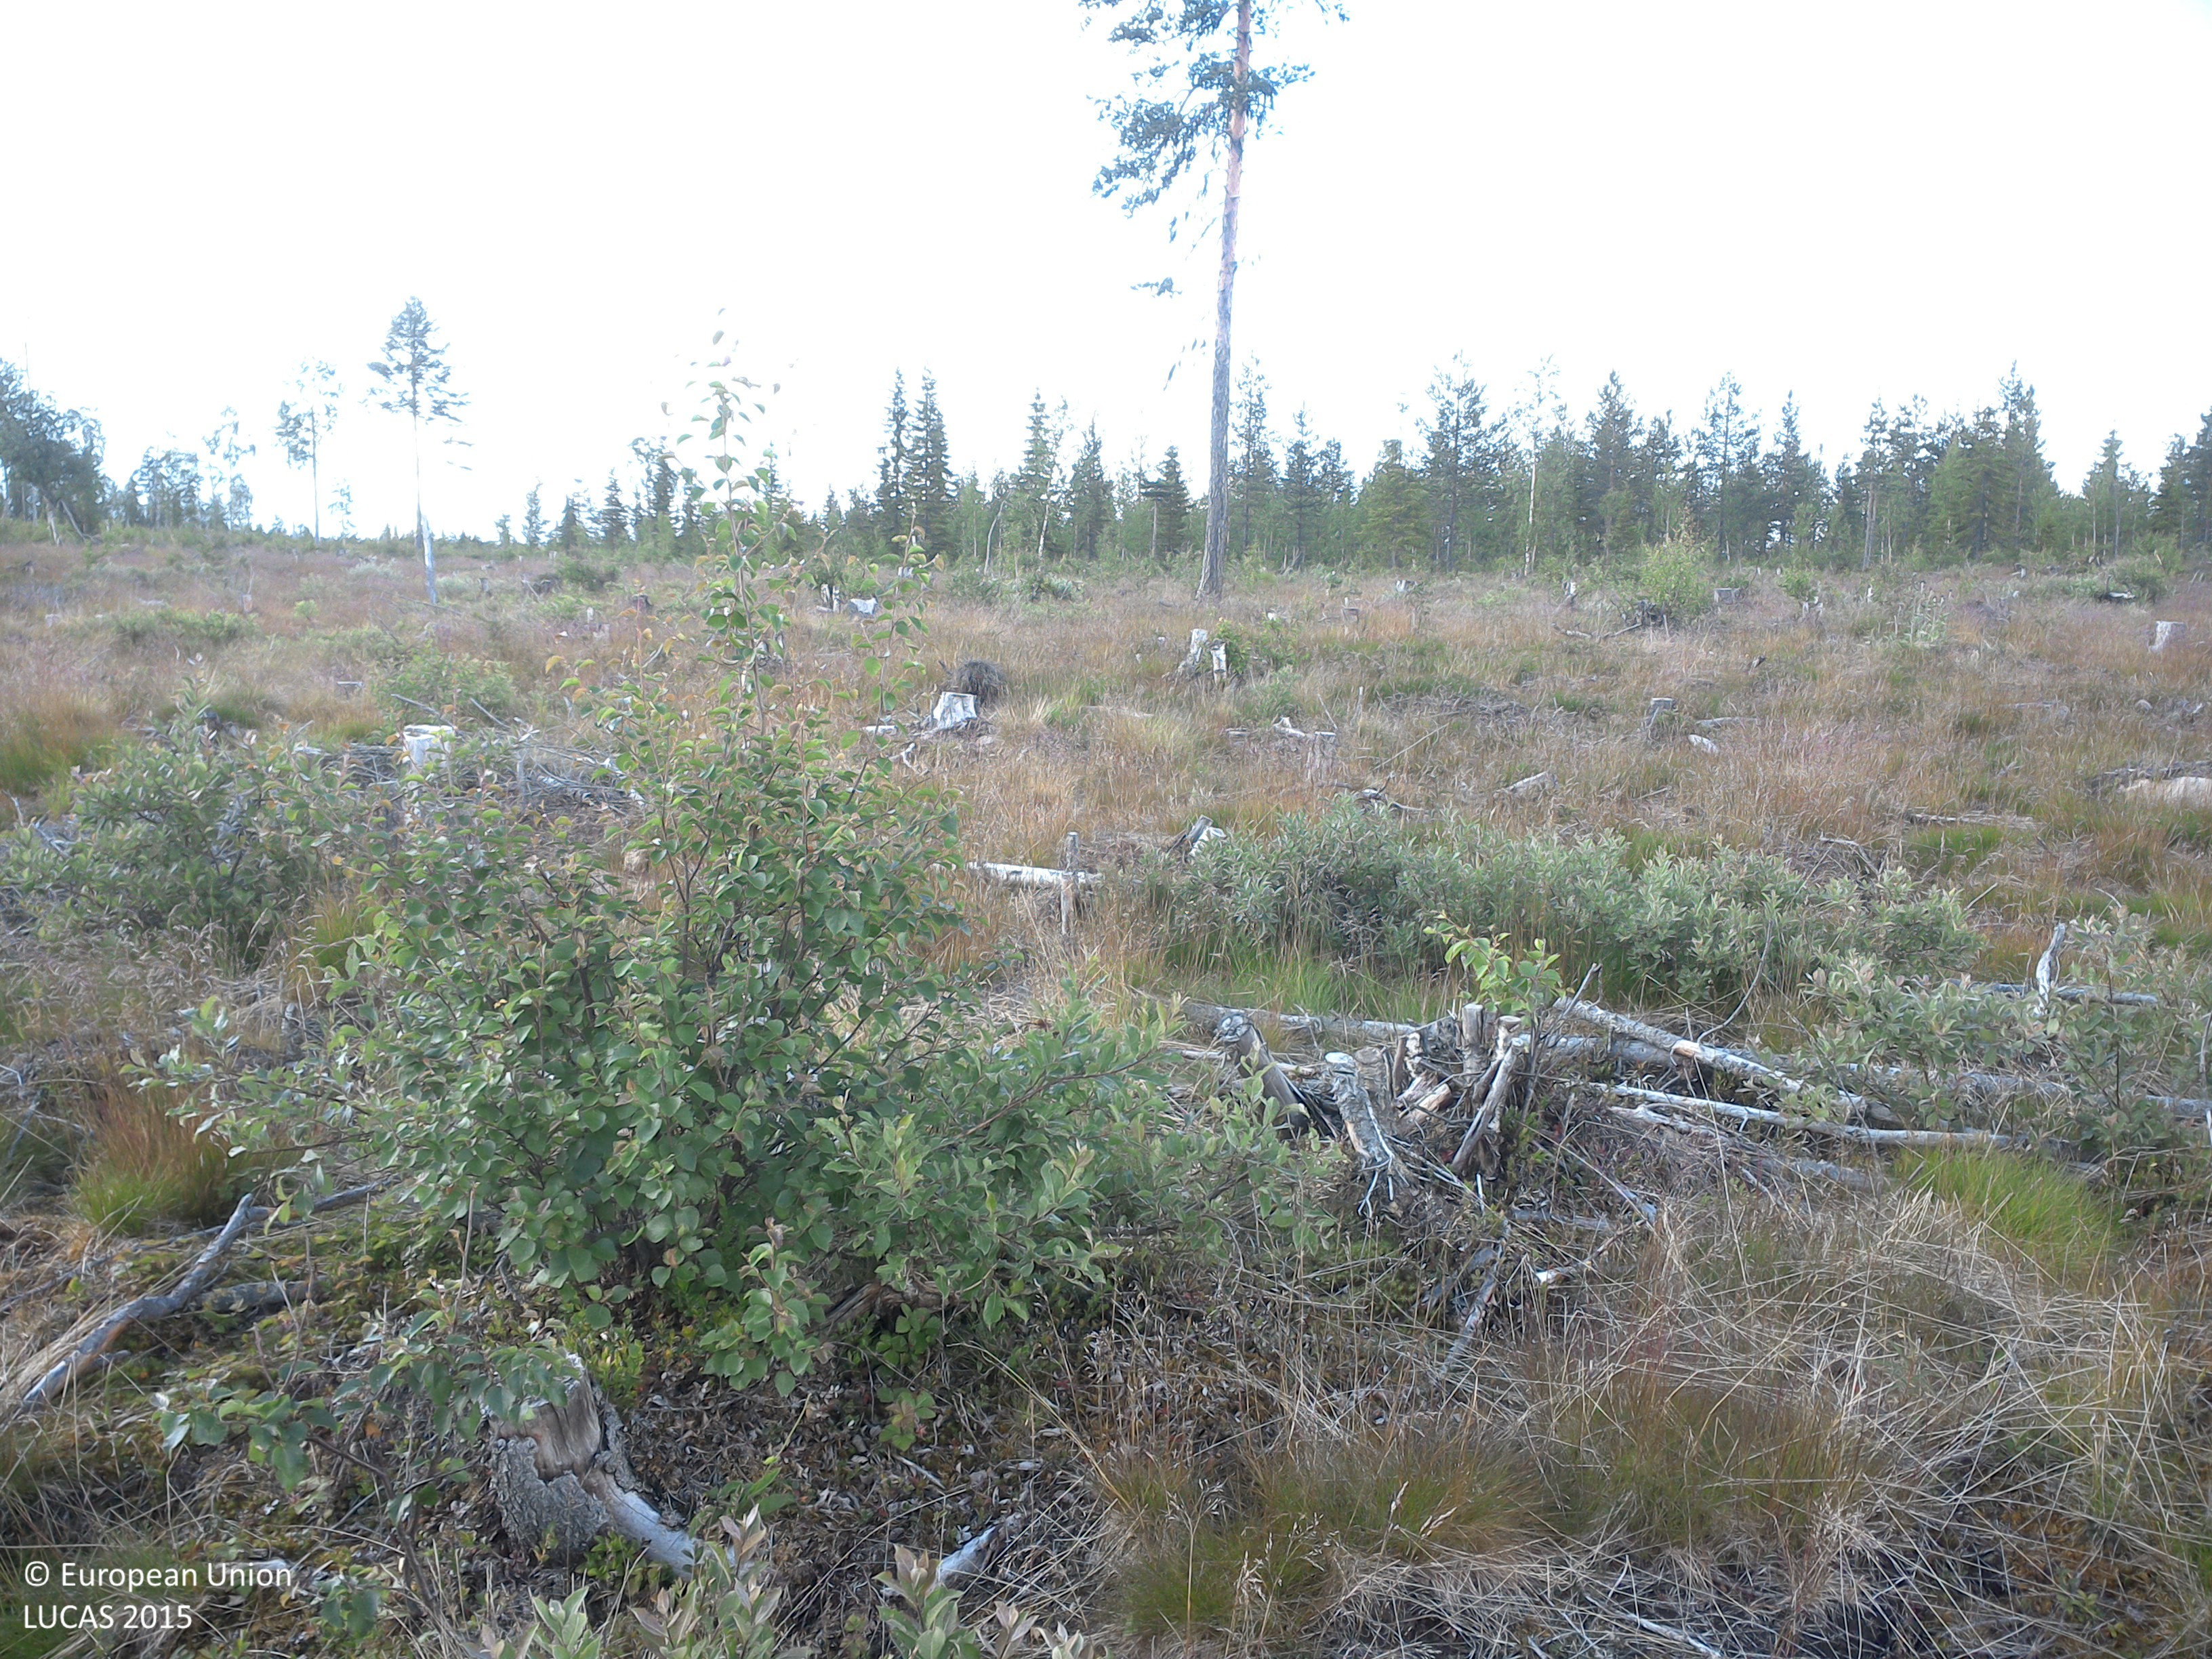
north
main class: Shrubland
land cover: Shrubland with sparse tree cover
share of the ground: 25 - 50 %
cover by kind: herbaceous plants 40 %, shrubs 25 %, unconsolidated bare surface 20 %, lichens and mosses 10 %, broadleaved forest trees 5 %
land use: Forestry
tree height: < 5 m
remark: Clear cut
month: July
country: SE
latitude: 67.7076
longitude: 23.4541
